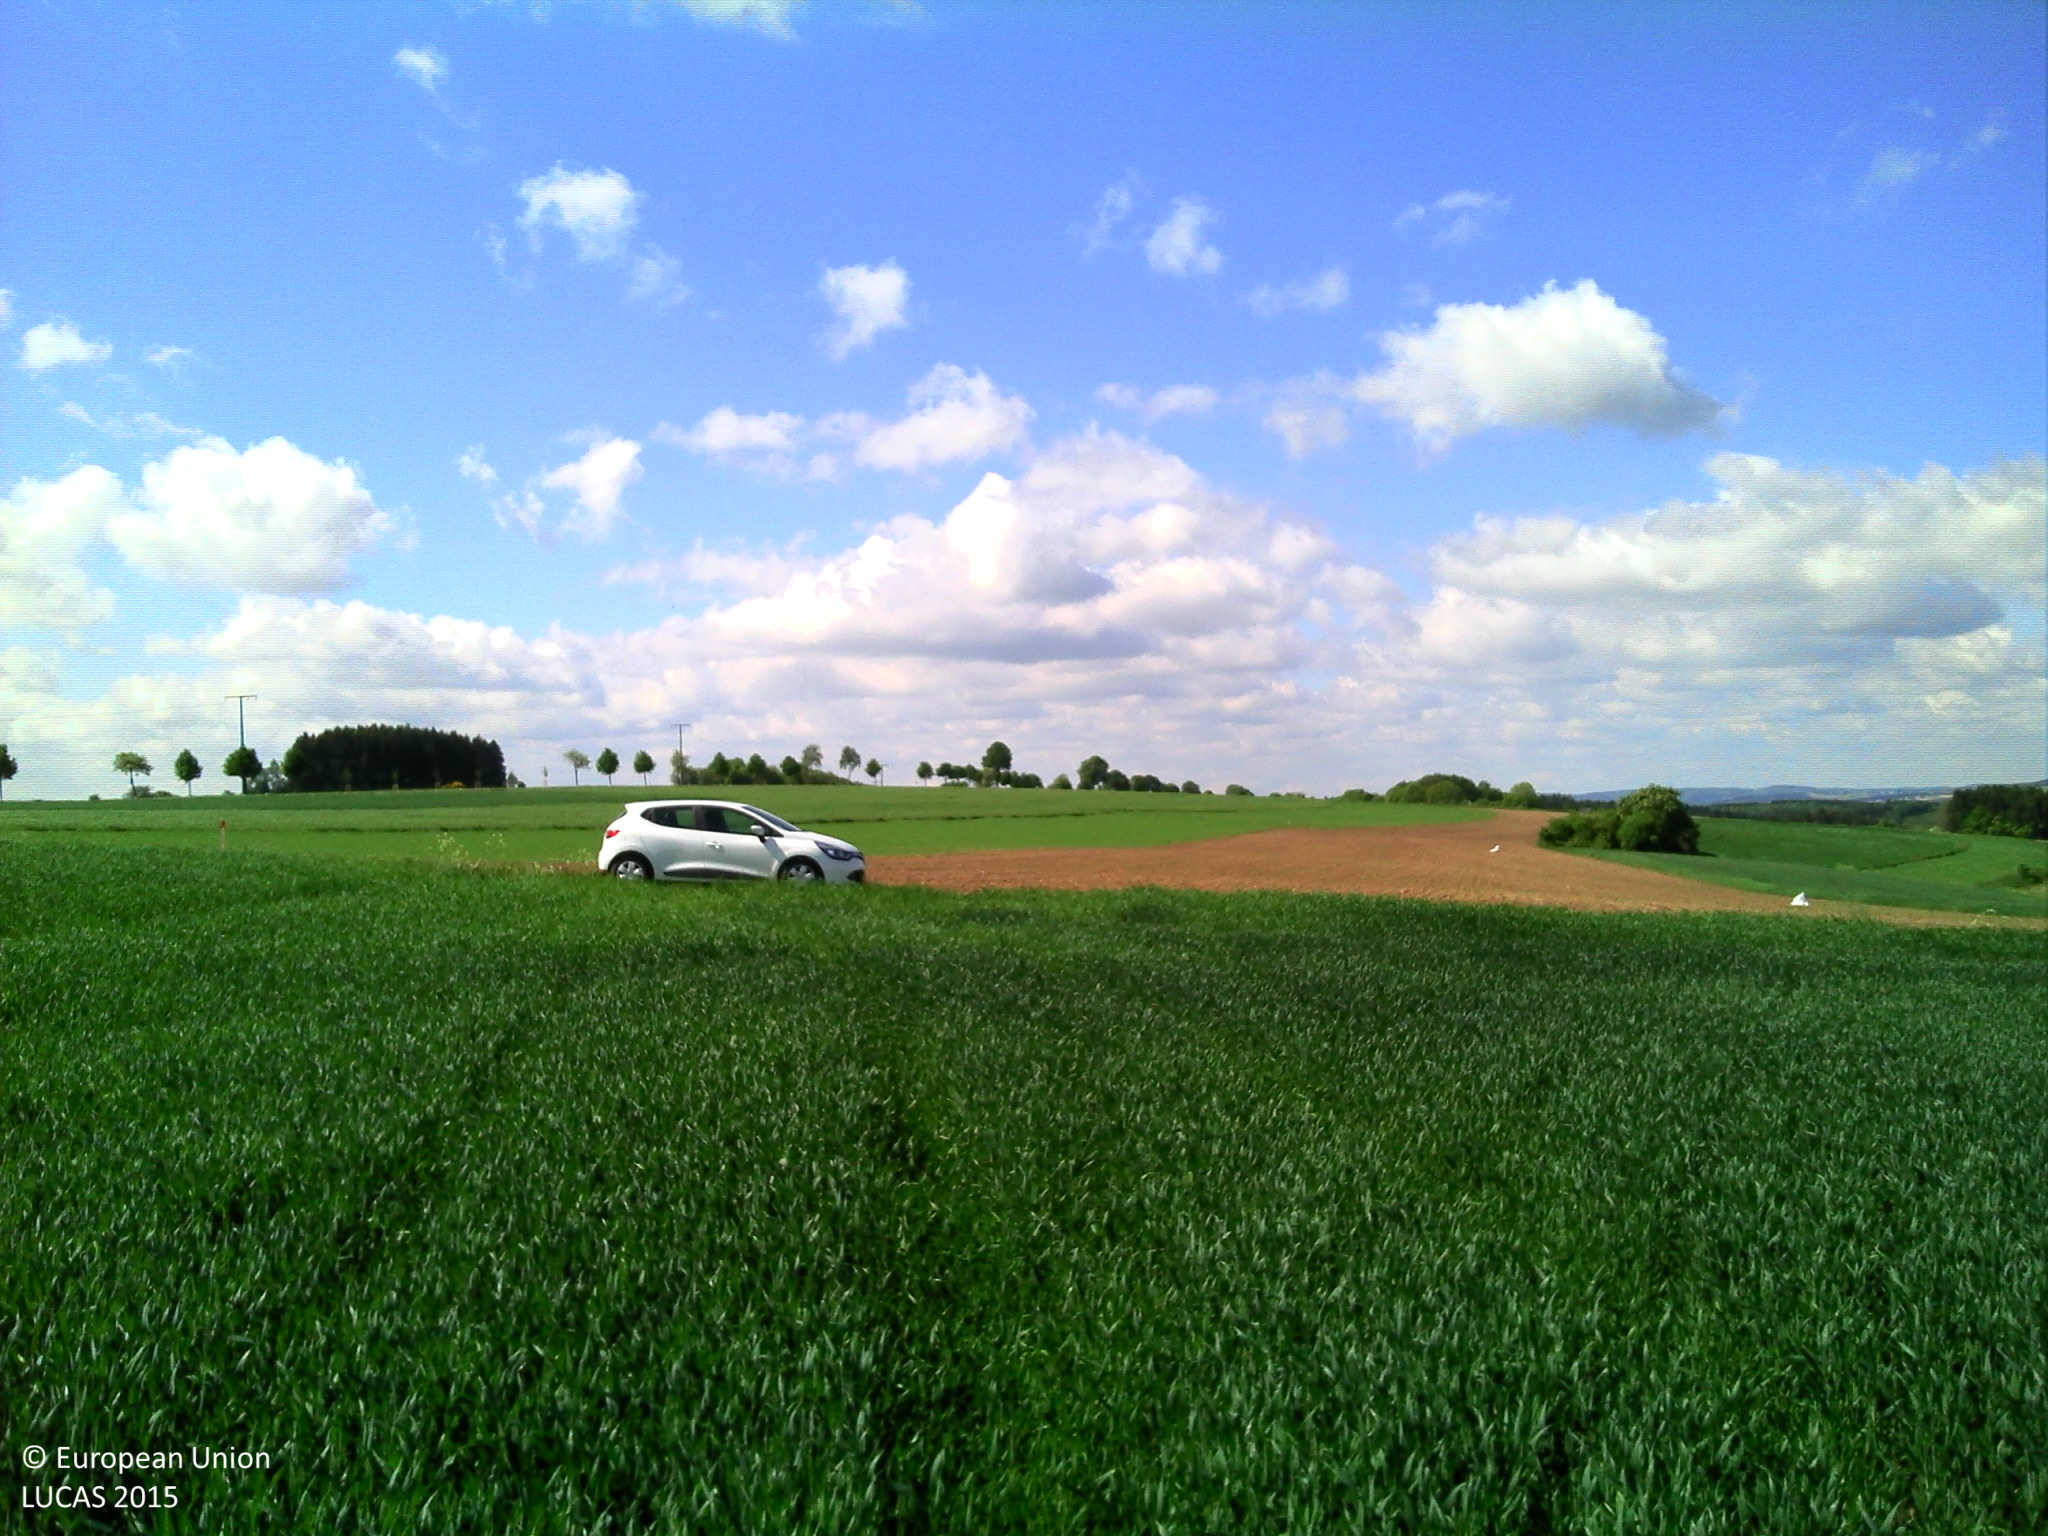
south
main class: Cropland
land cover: Common wheat
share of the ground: > 75 %
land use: Agriculture (excluding fallow land and kitchen gardens)
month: May
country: LU
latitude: 50.0438
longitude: 6.0474
